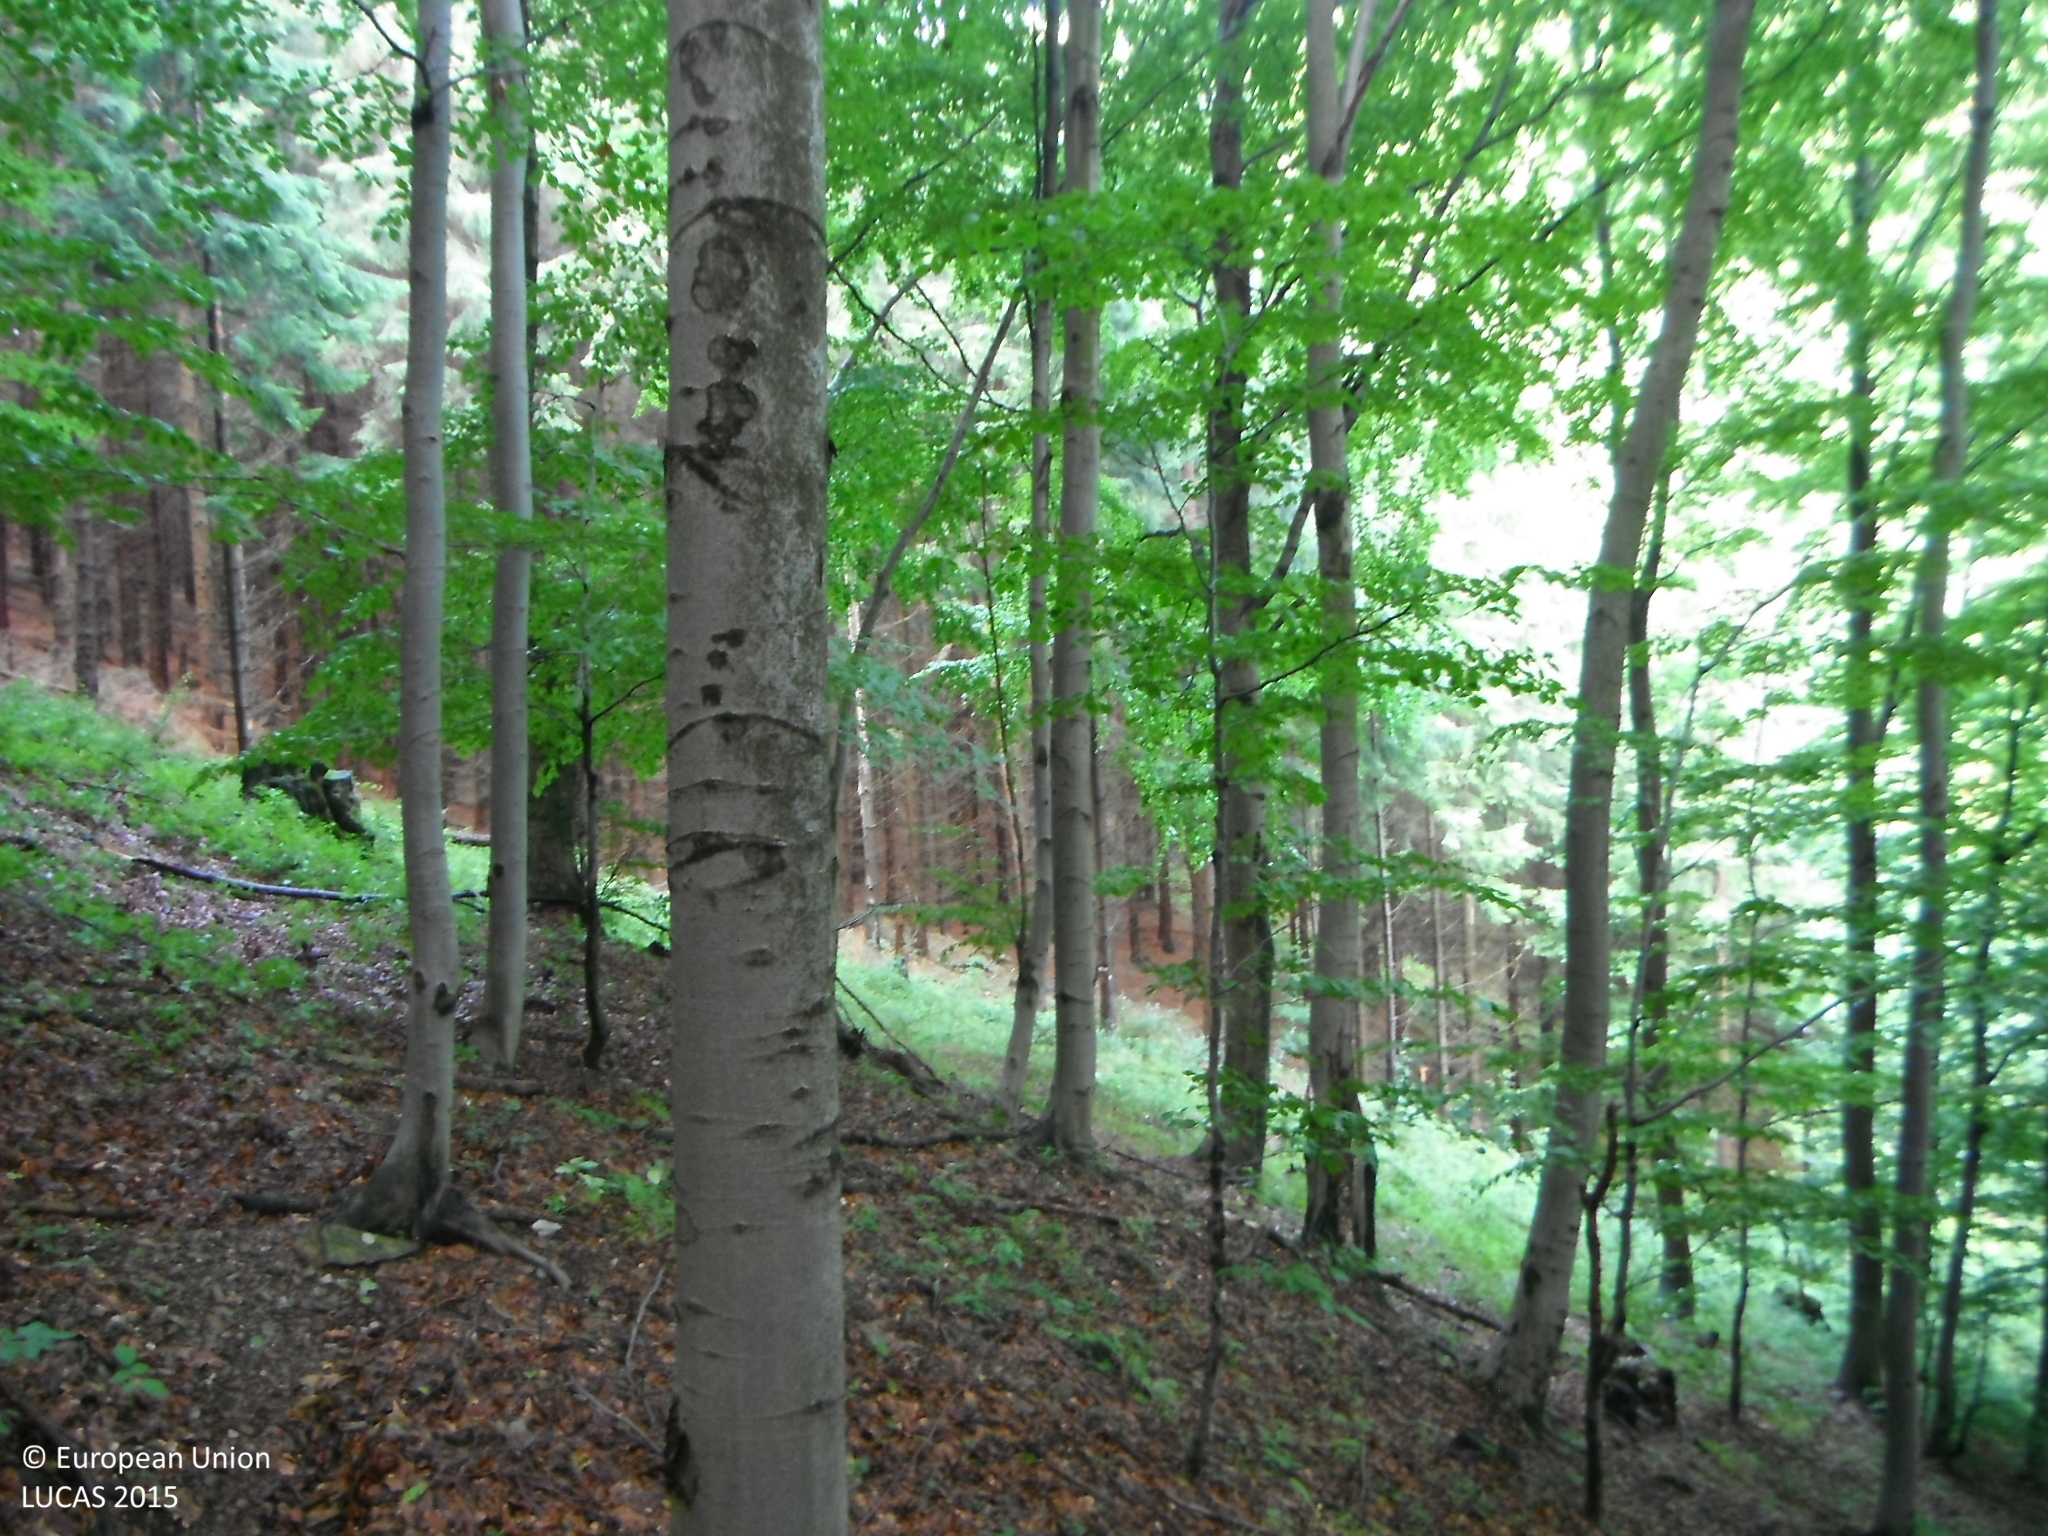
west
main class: Woodland
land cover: Broadleaved woodland
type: beech forest
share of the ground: > 75 %
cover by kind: broadleaved forest trees 100 %
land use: Forestry
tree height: > 5 m
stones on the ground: 10 - 25 %
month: August
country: SK
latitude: 48.8235
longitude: 18.4209
